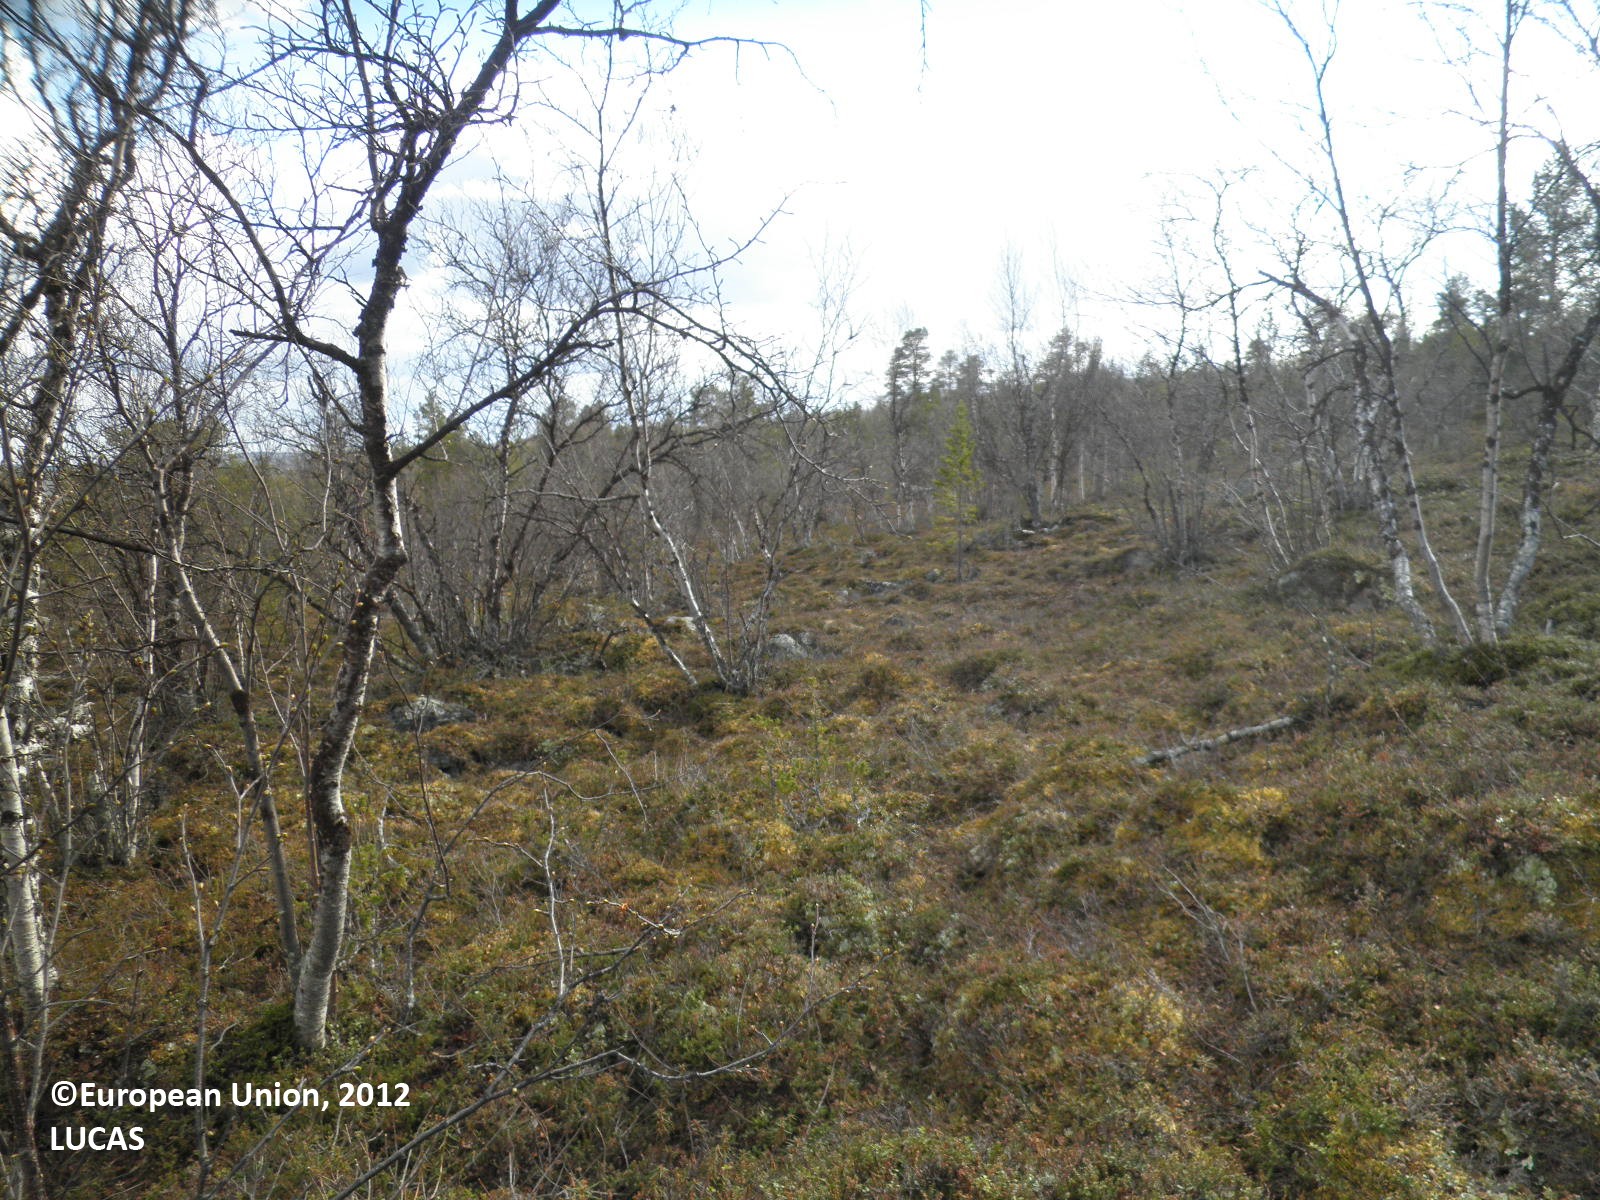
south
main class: Woodland
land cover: Broadleaved woodland
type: hemiboreal forest and nemoral coniferous forest and mixed broadleaved-coniferous forest
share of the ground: 50 - 75 %
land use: Forestry
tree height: > 5 m
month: May
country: FI
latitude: 69.7944
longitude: 26.9826
